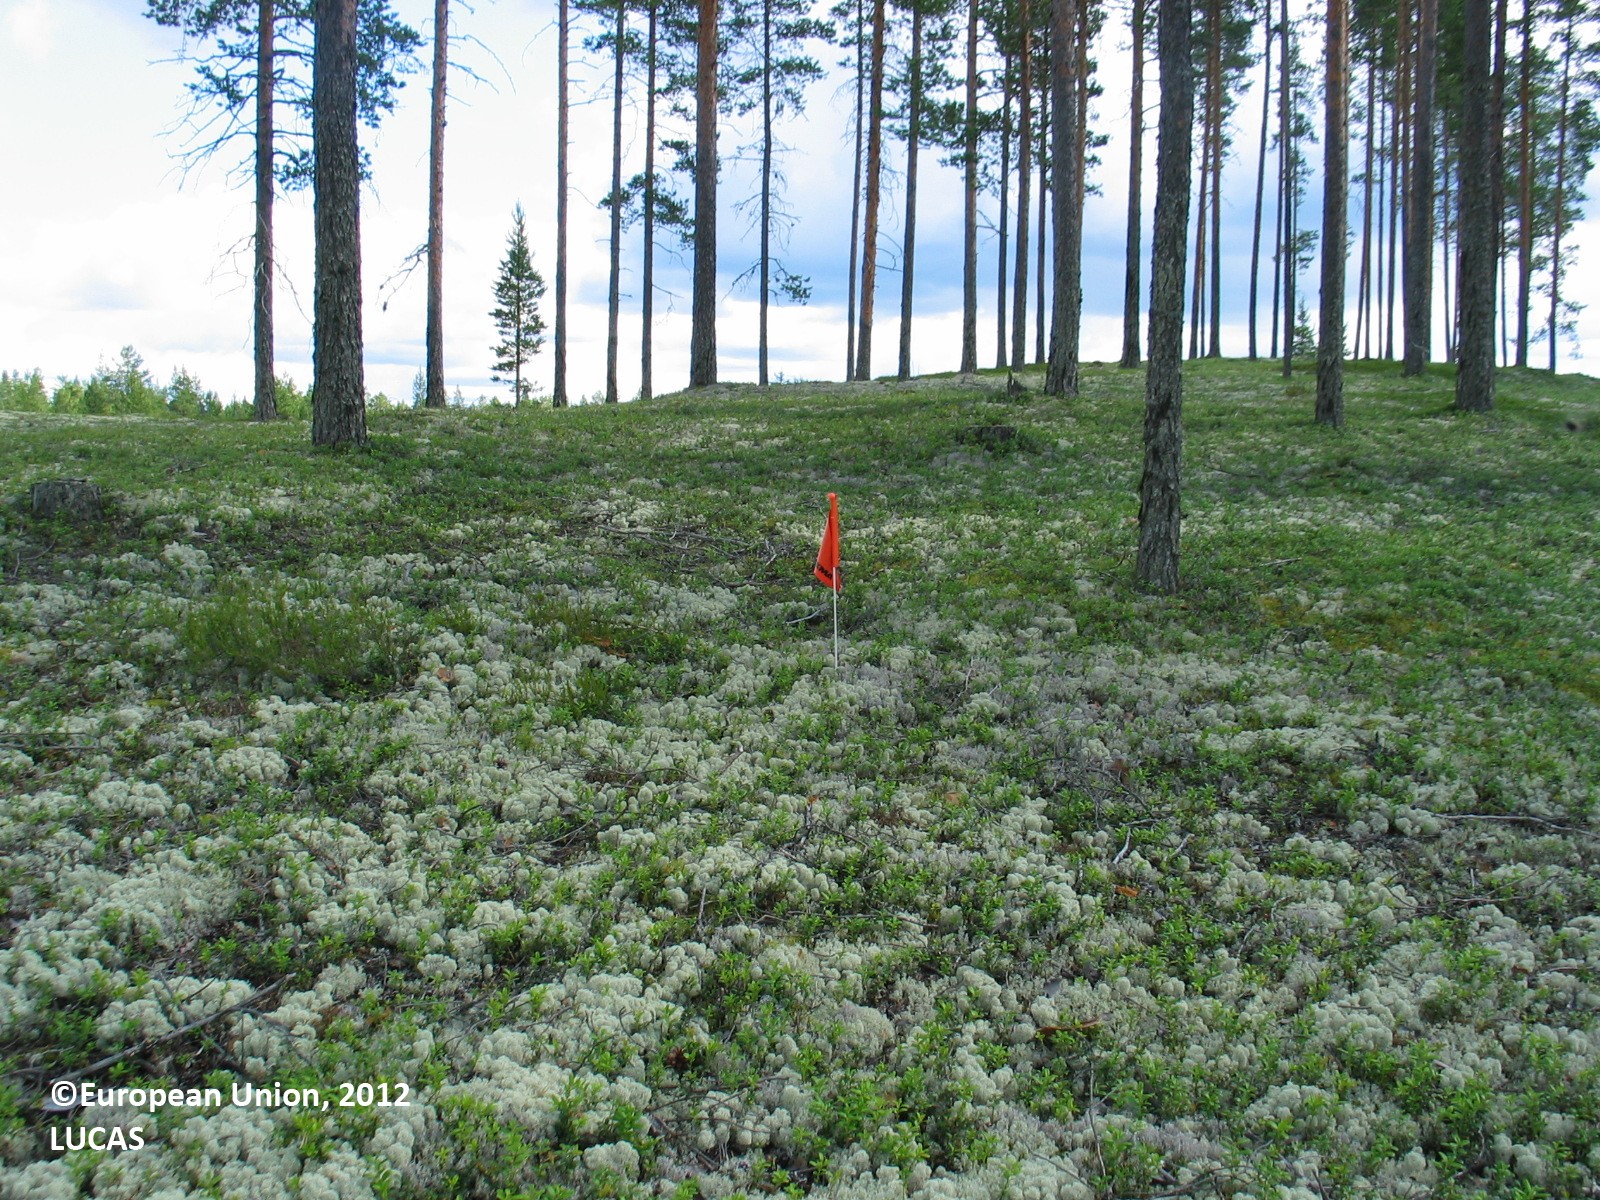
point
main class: Woodland
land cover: Pine dominated coniferous woodland
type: boreal forest
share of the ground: 25 - 50 %
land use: Forestry
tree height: > 5 m
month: July
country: FI
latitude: 64.5992
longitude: 26.5157
